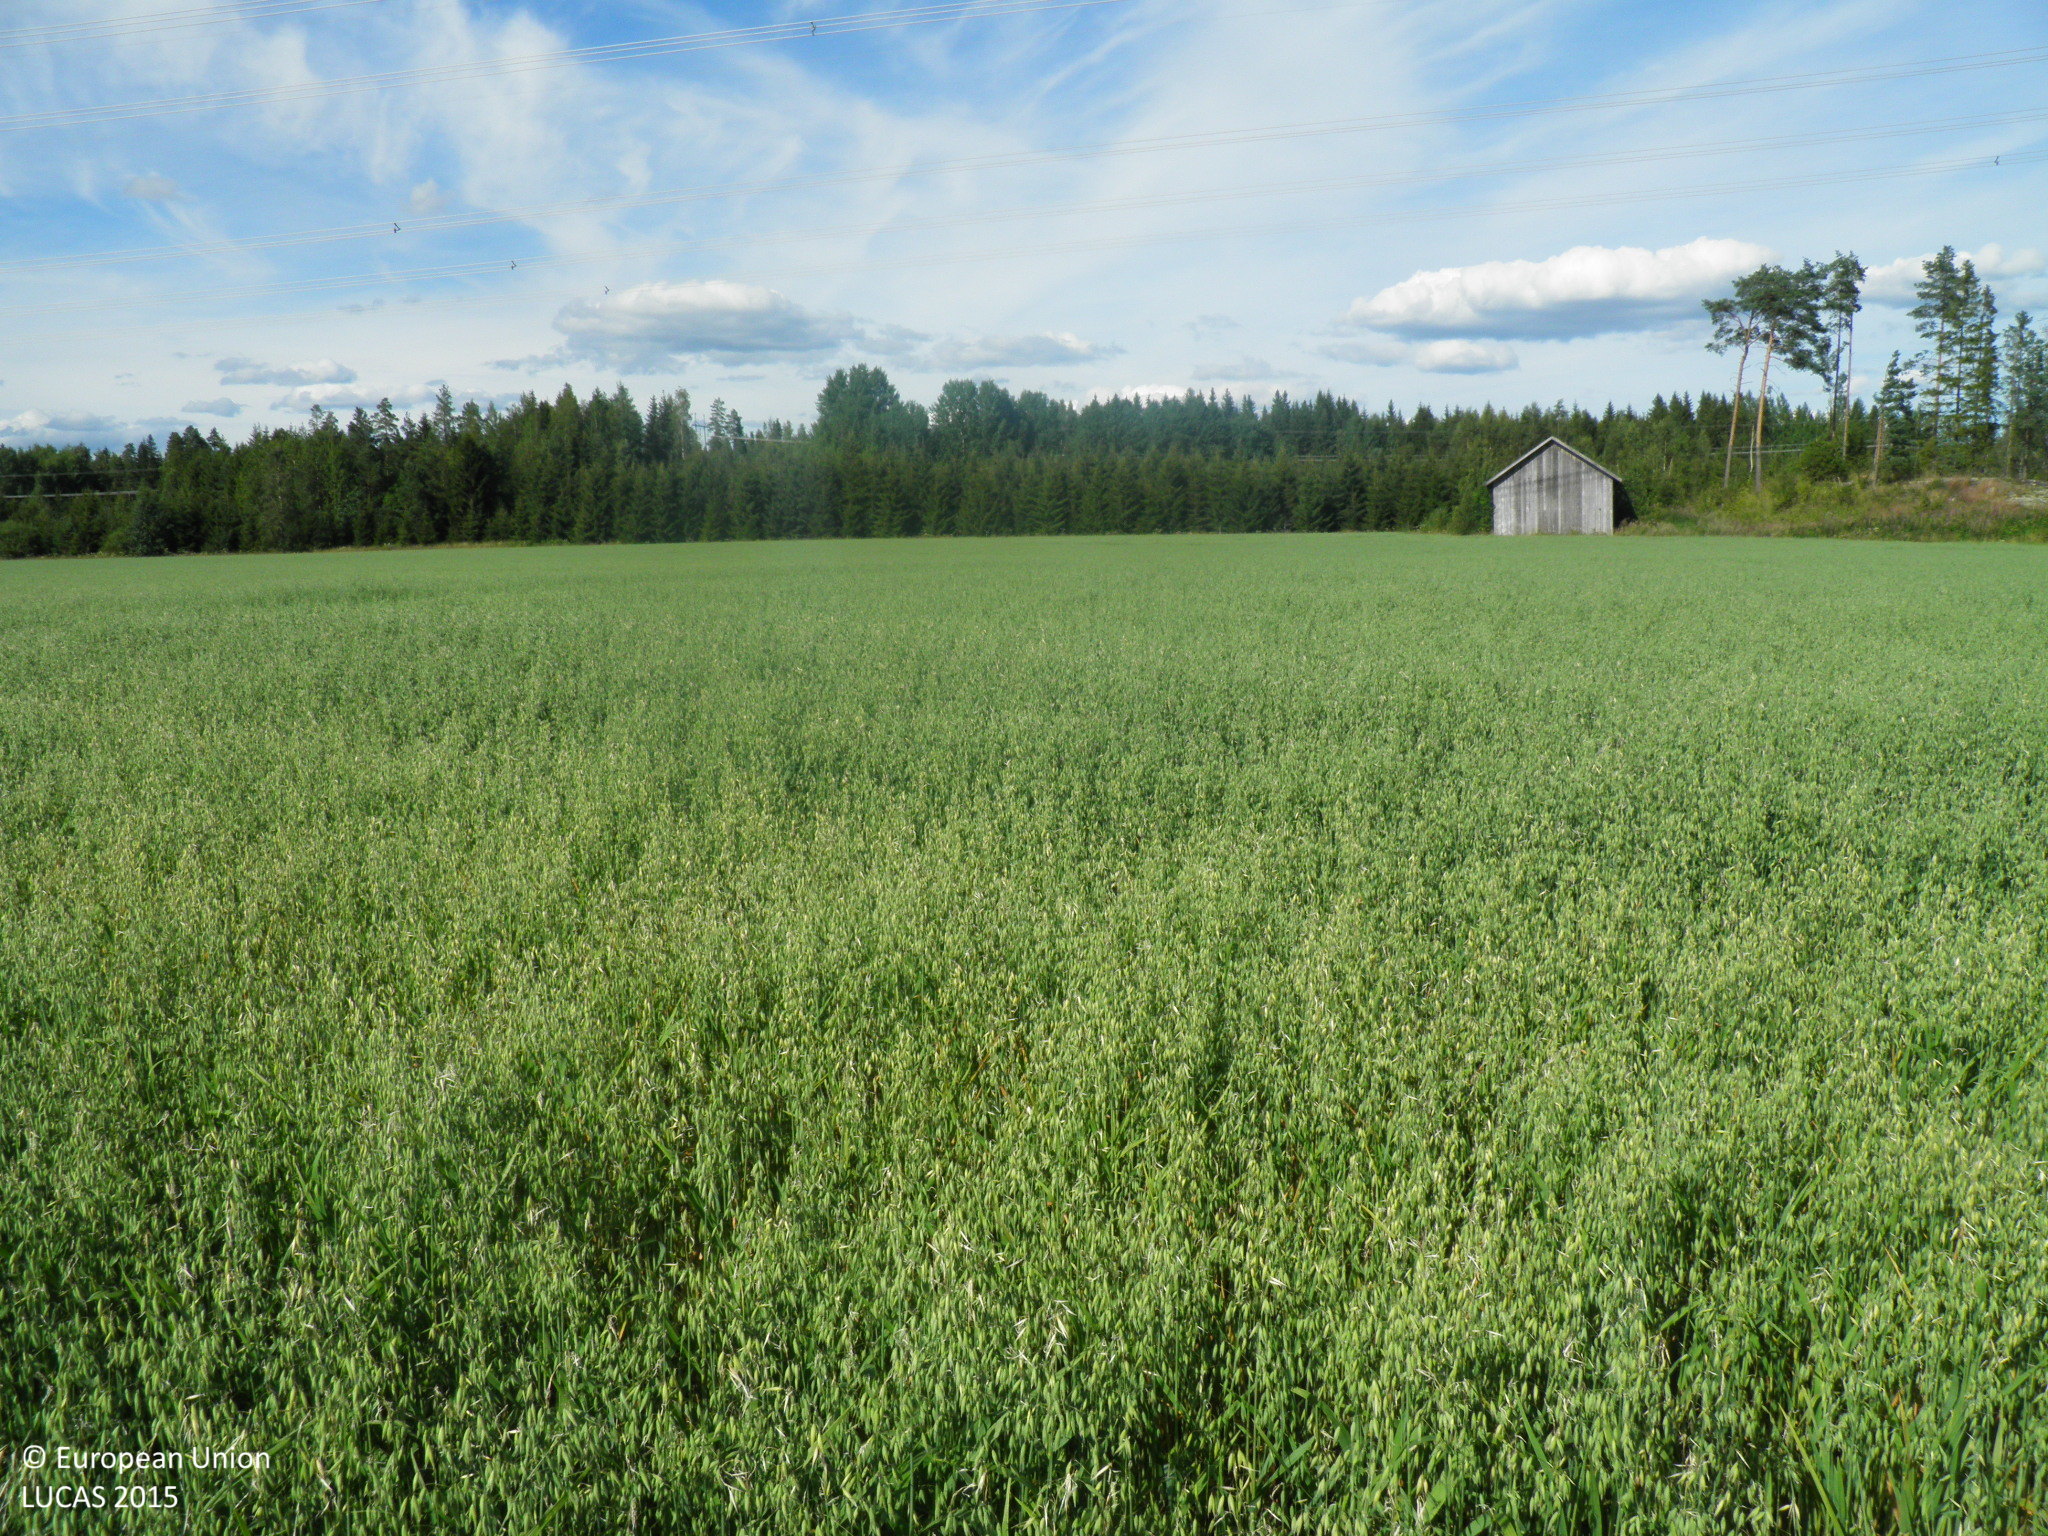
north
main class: Cropland
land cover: Oats
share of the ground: > 75 %
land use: Agriculture (excluding fallow land and kitchen gardens)
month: August
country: FI
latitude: 61.1471
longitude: 22.6068
